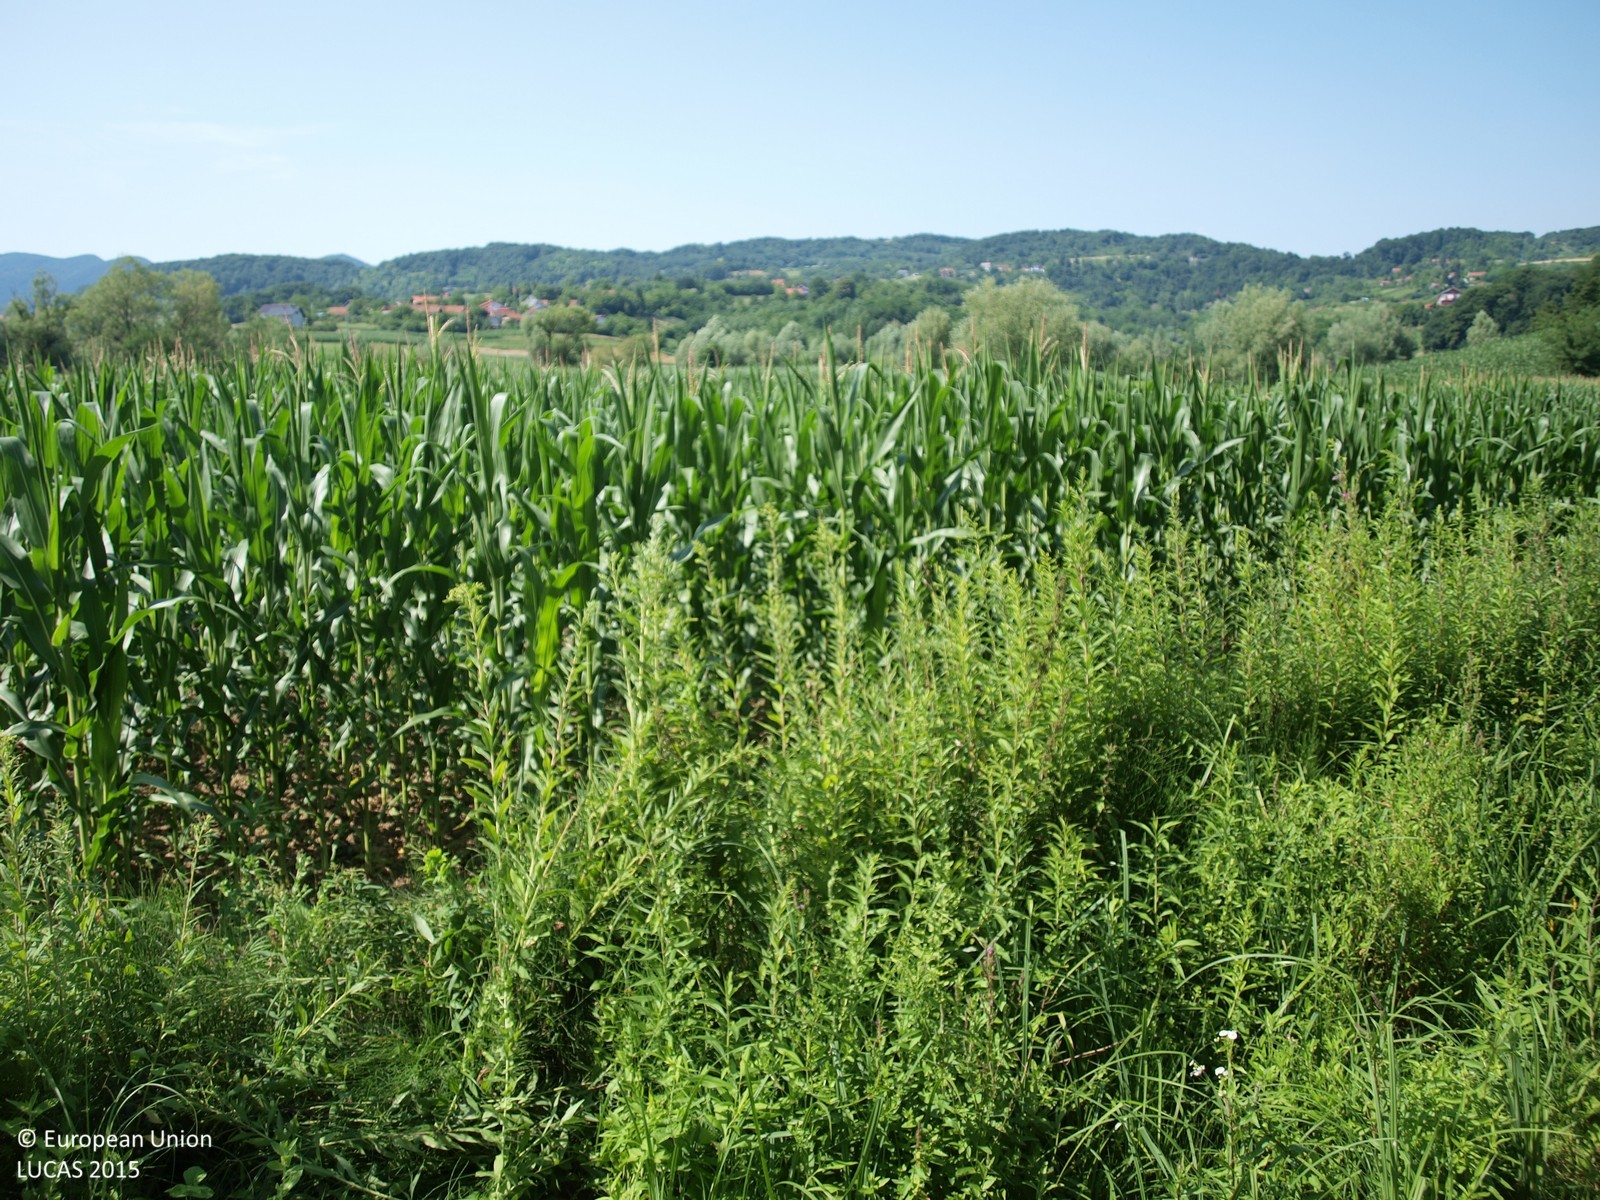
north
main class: Grassland
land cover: Grassland without tree/shrub cover
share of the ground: > 75 %
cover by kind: herbaceous plants 100 %
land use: Agriculture (excluding fallow land and kitchen gardens)
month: July
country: HR
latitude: 46.1485
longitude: 15.9674
